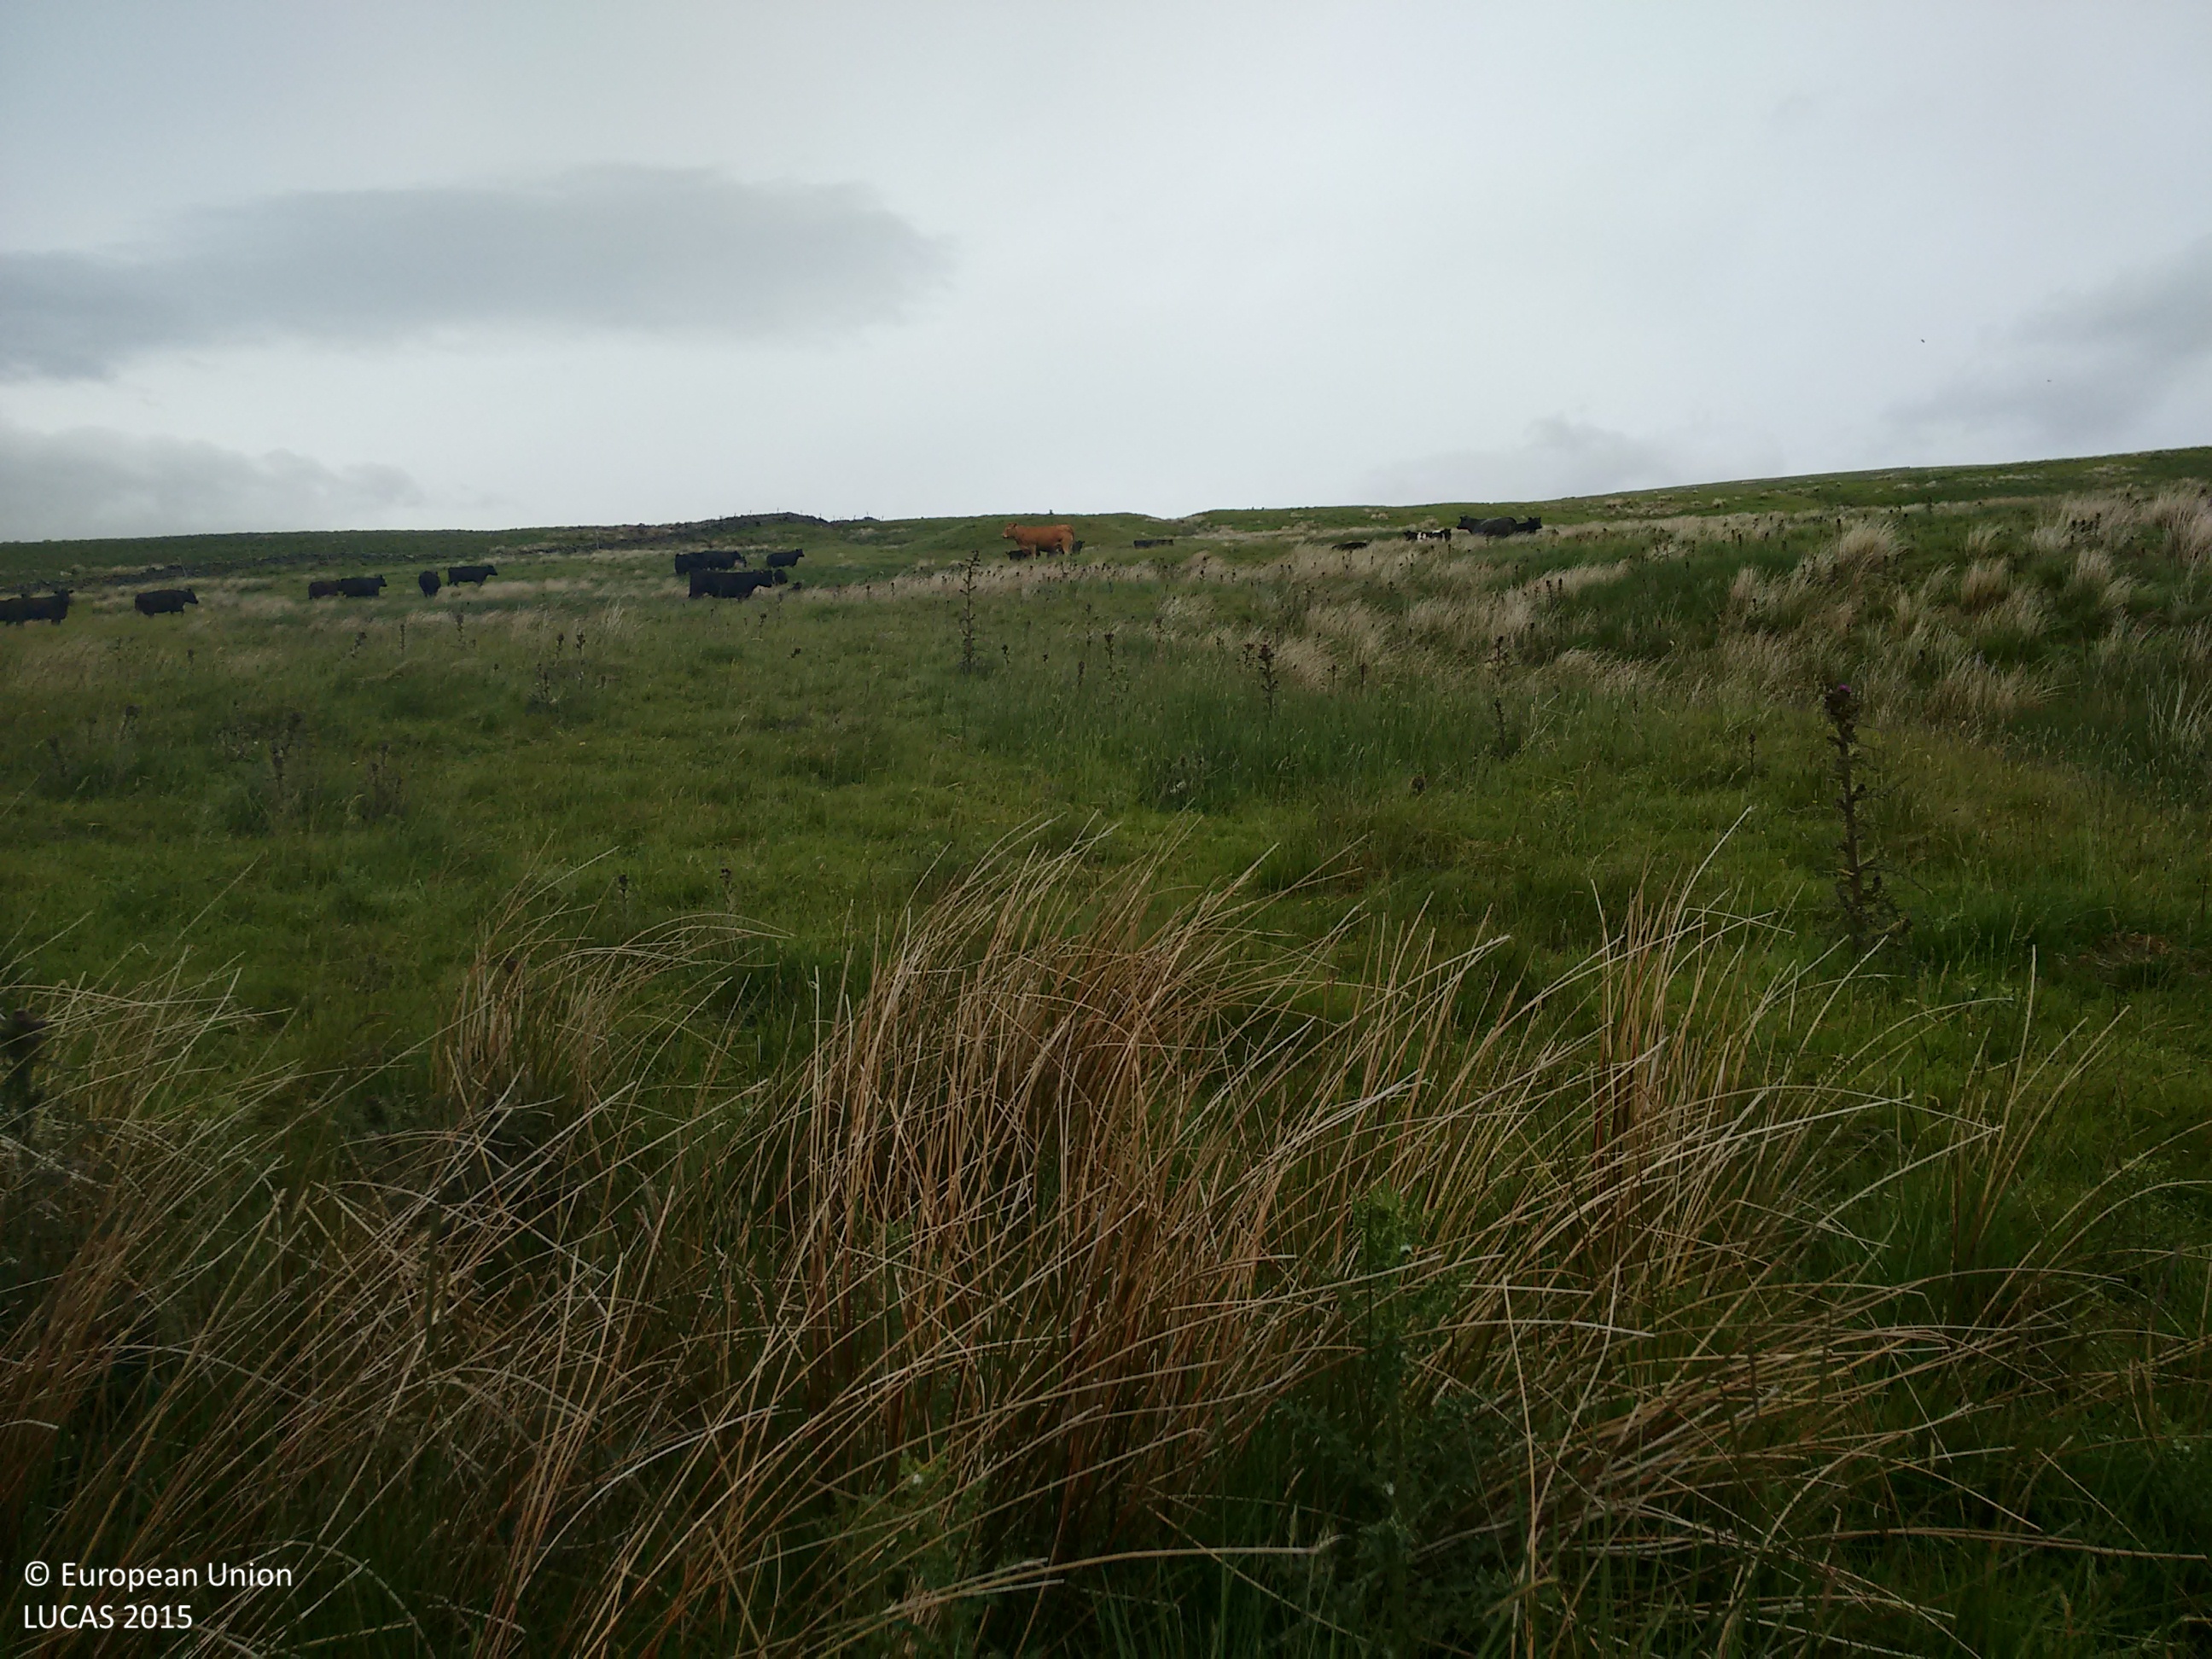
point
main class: Grassland
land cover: Grassland without tree/shrub cover
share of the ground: > 75 %
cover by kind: herbaceous plants 100 %
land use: Agriculture (excluding fallow land and kitchen gardens)
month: June
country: GB
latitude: 54.7689
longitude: -2.1663
